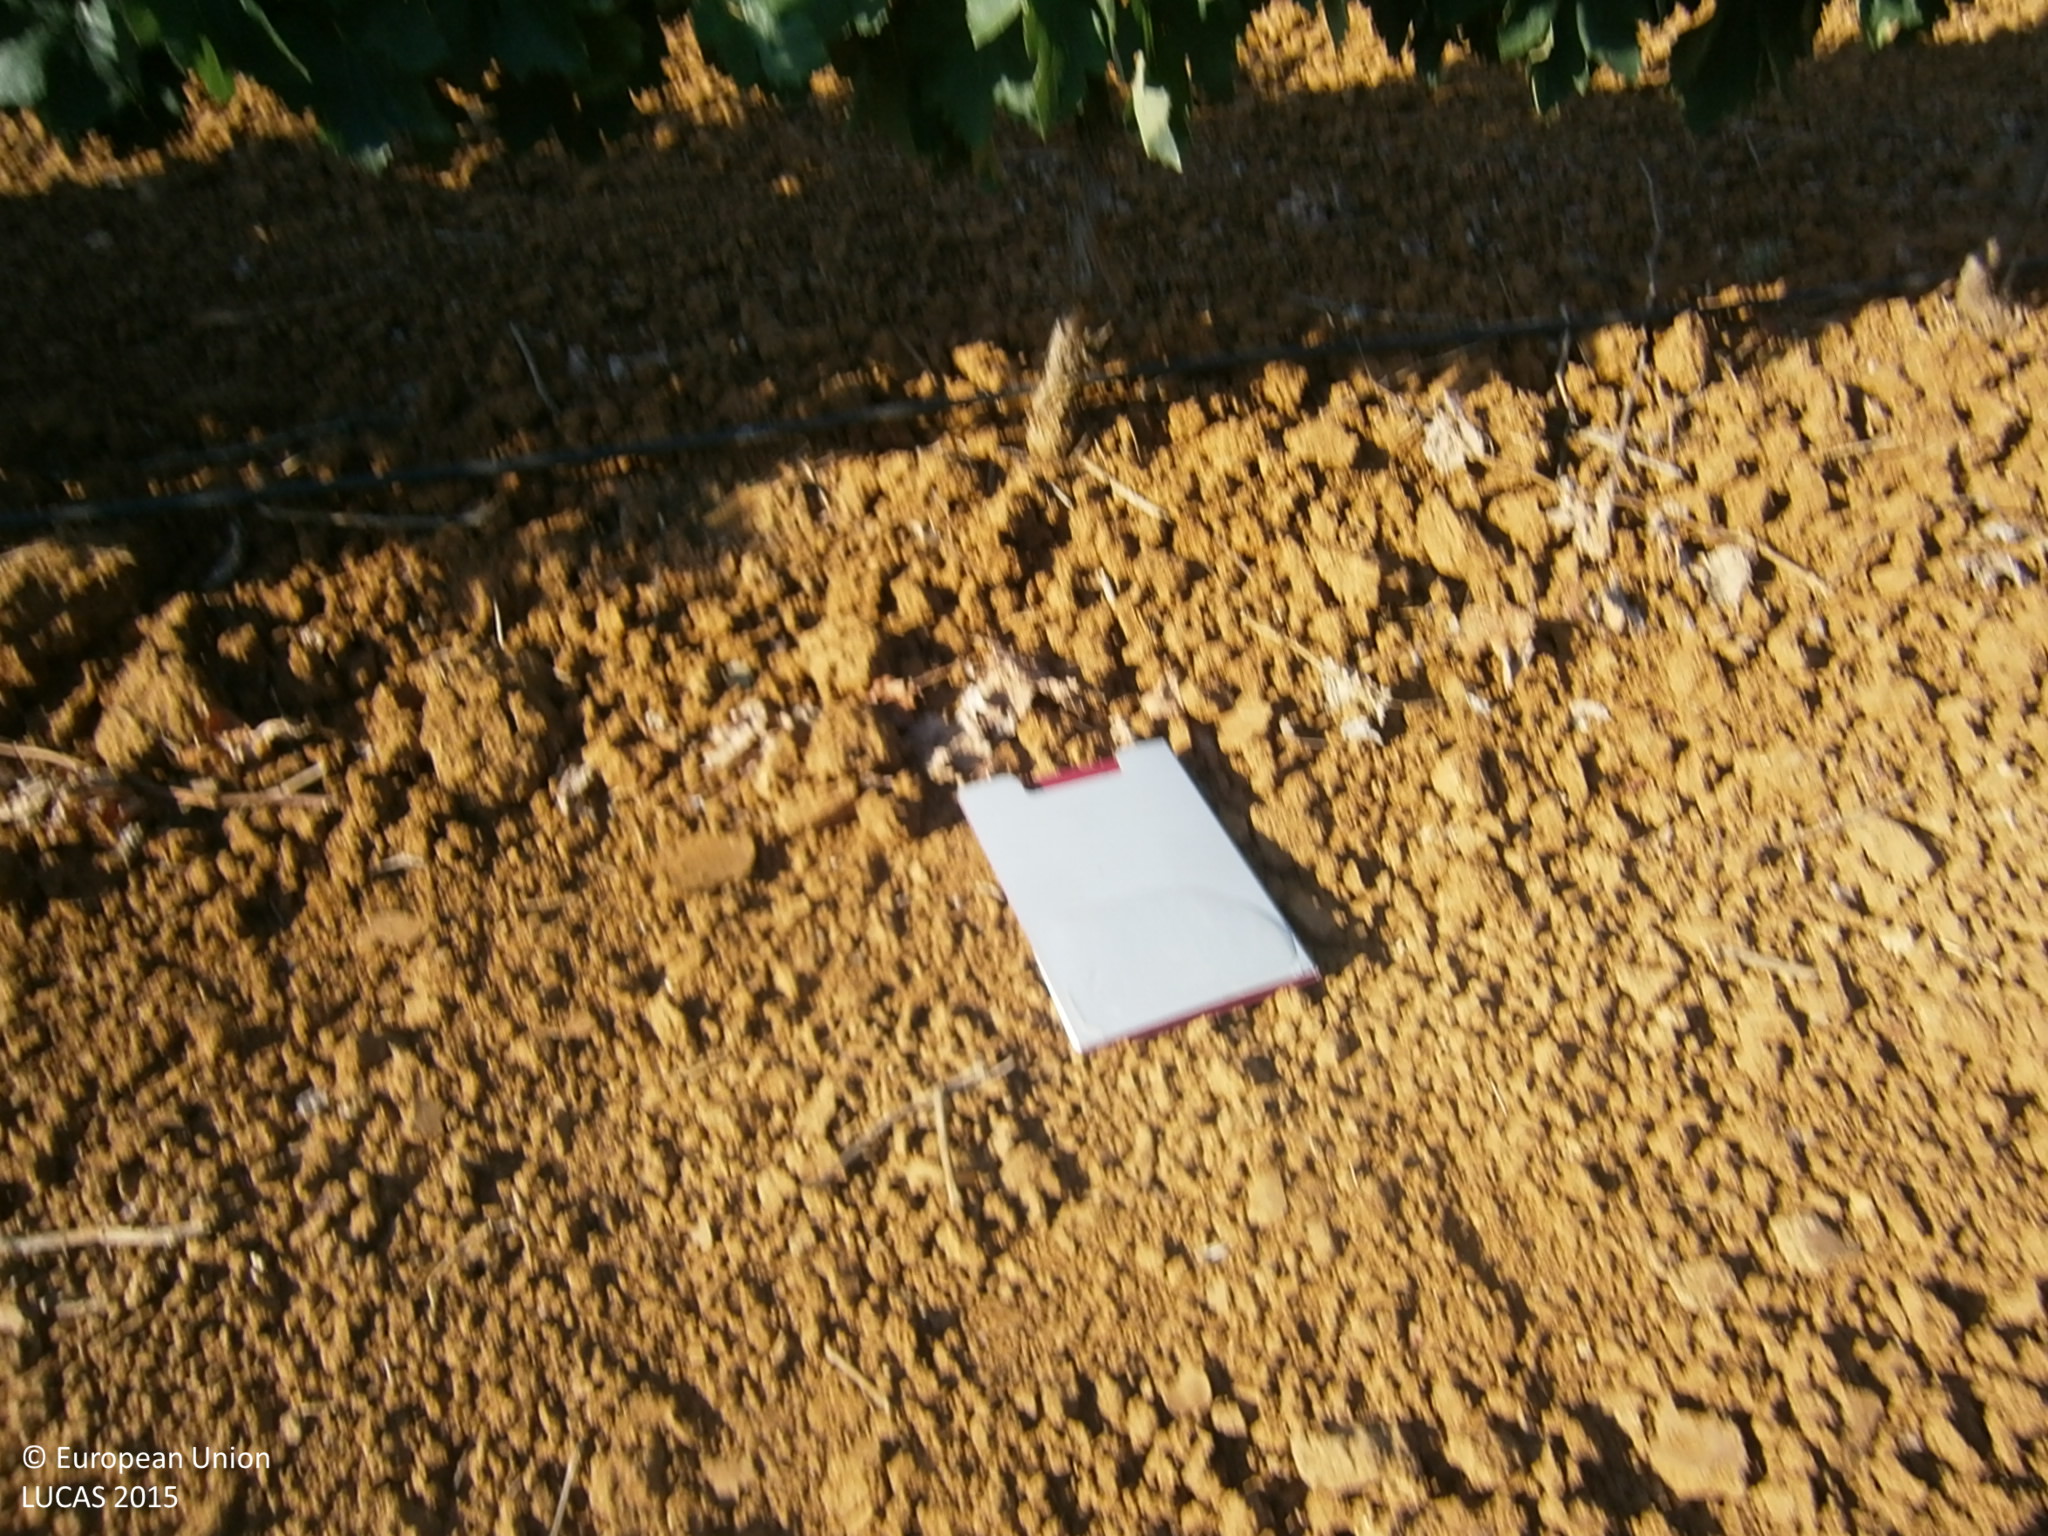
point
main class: Cropland
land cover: Vineyards
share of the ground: 25 - 50 %
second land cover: Other bare soil
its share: > 75 %
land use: Agriculture (excluding fallow land and kitchen gardens)
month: June
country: ES
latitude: 38.7938
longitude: -6.7699
